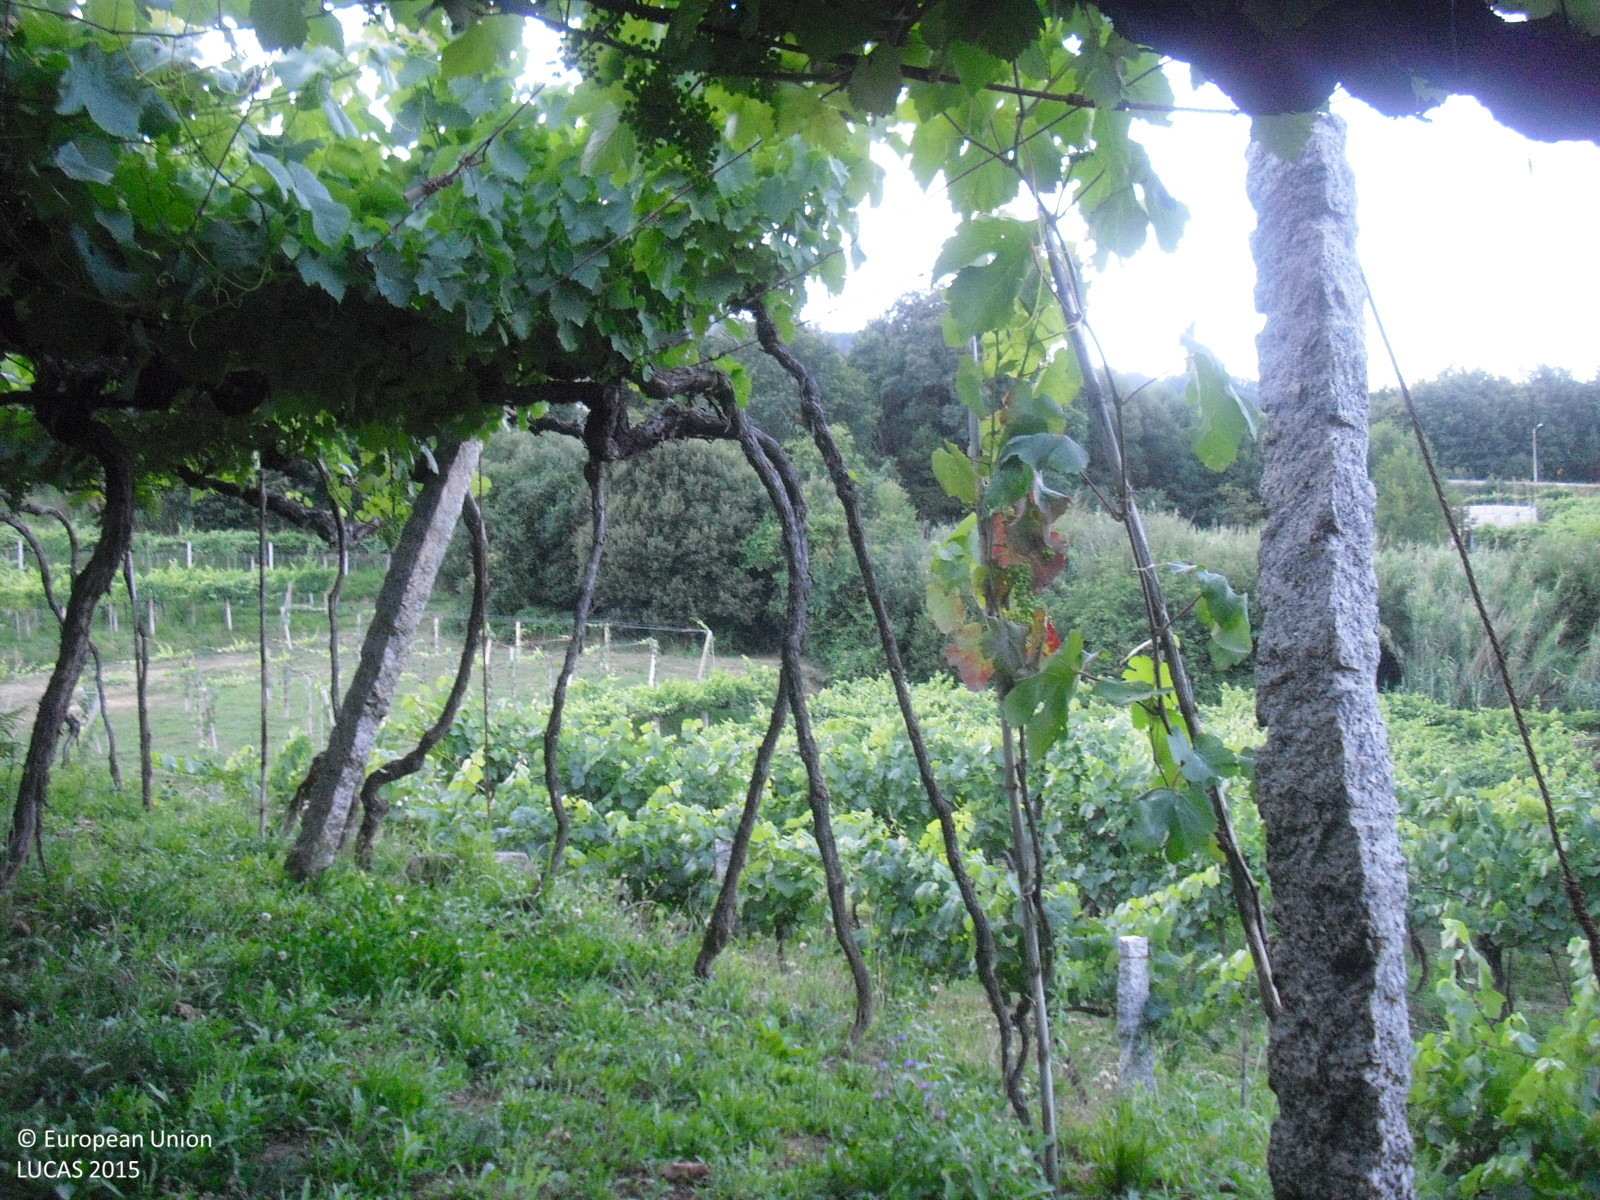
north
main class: Cropland
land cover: Vineyards
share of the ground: > 75 %
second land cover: Grassland without tree/shrub cover
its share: > 75 %
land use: Agriculture (excluding fallow land and kitchen gardens)
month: June
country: ES
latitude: 42.1432
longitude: -8.2475
